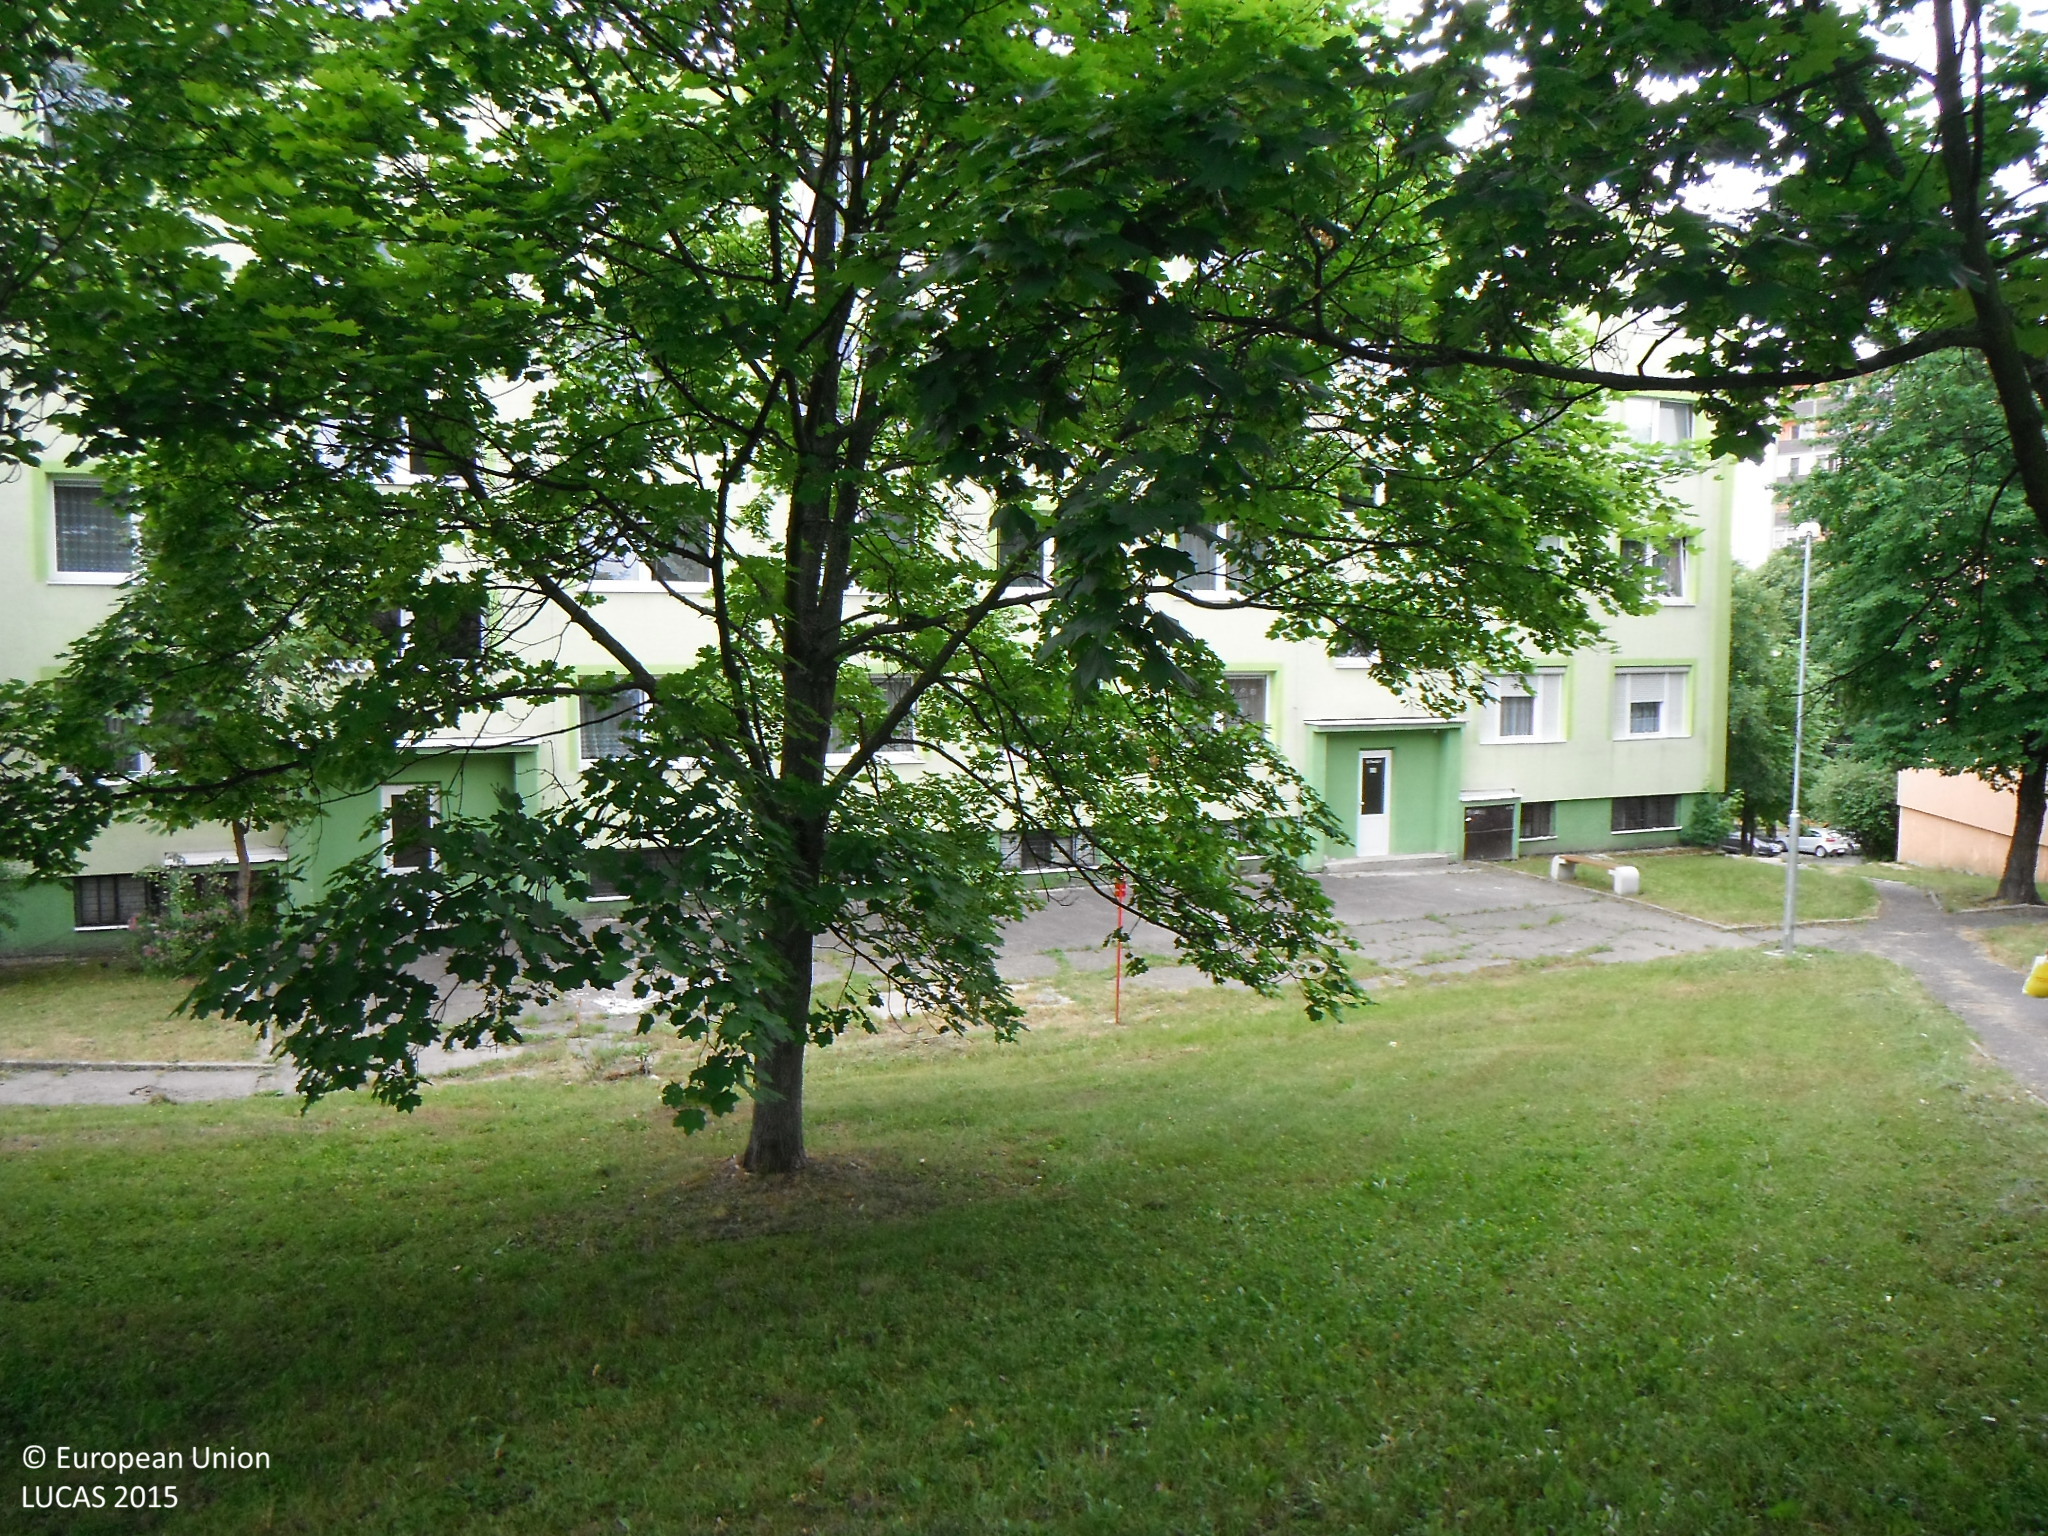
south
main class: Woodland
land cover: Broadleaved woodland
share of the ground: 50 - 75 %
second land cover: Grassland without tree/shrub cover
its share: > 75 %
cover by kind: broadleaved forest trees 70 %, herbaceous plants 30 %
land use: Residential
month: June
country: SK
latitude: 48.2060
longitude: 19.3478
